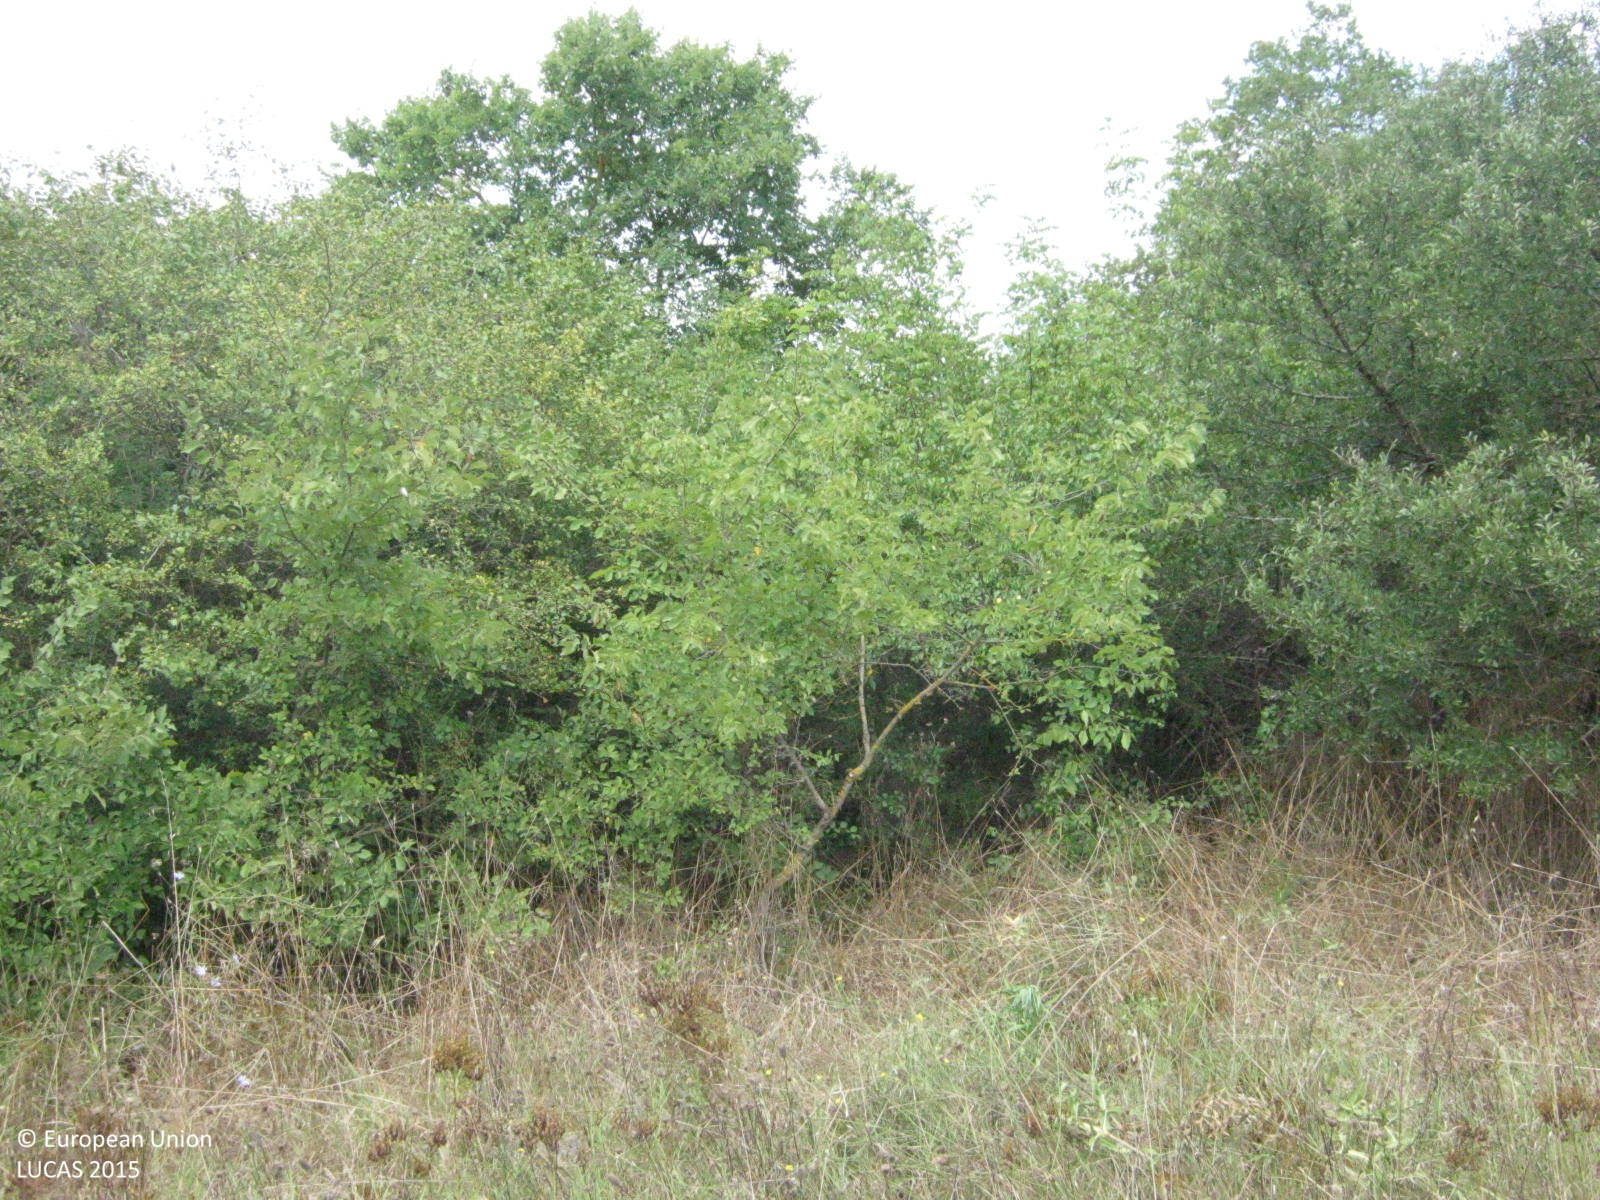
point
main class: Shrubland
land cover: Shrubland with sparse tree cover
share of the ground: > 75 %
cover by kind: shrubs 95 %, coniferous forest trees 5 %
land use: Semi-natural and natural areas not in use
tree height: < 5 m
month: August
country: GR
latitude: 40.9213
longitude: 22.9656
